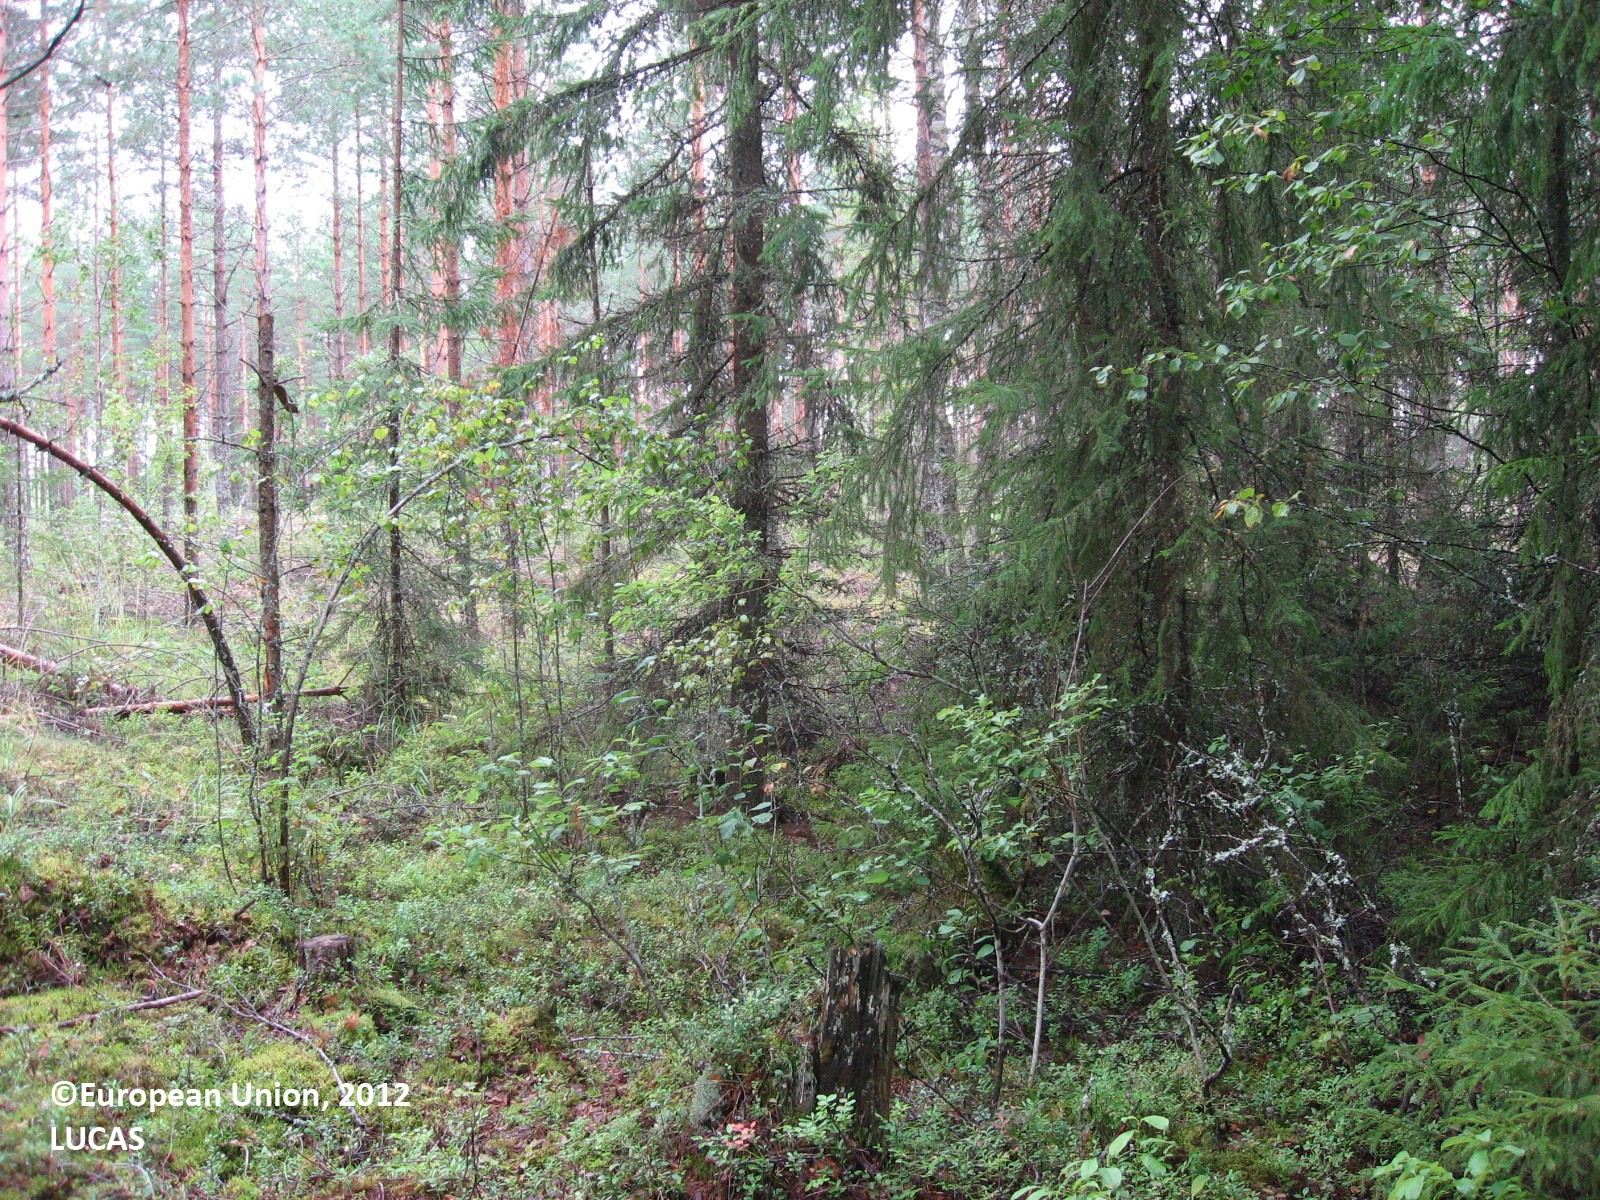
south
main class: Woodland
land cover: Spruce dominated mixed woodland
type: boreal forest
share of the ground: > 75 %
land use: Forestry
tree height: > 5 m
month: August
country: FI
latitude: 61.1080
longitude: 24.7460
